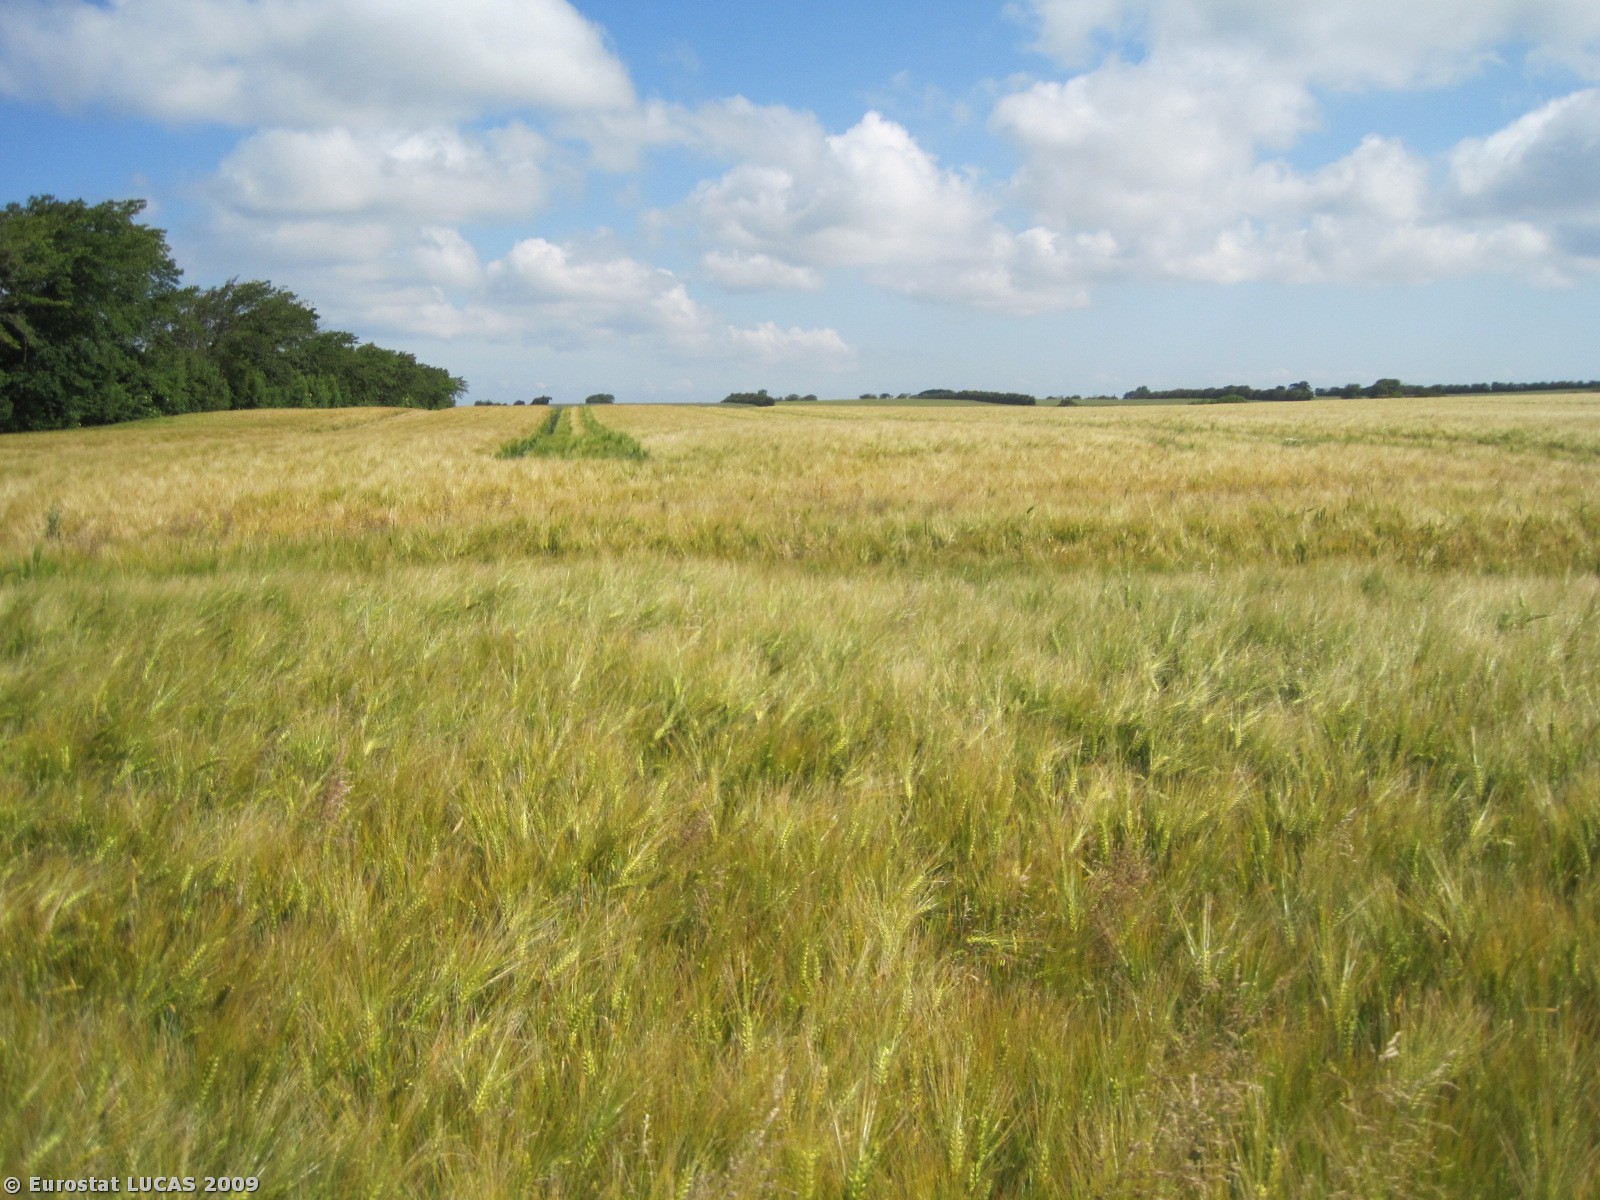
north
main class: Cropland
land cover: Barley
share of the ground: > 75 %
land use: Agriculture (excluding fallow land and kitchen gardens)
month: June
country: DK
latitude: 56.7925
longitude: 8.7084
